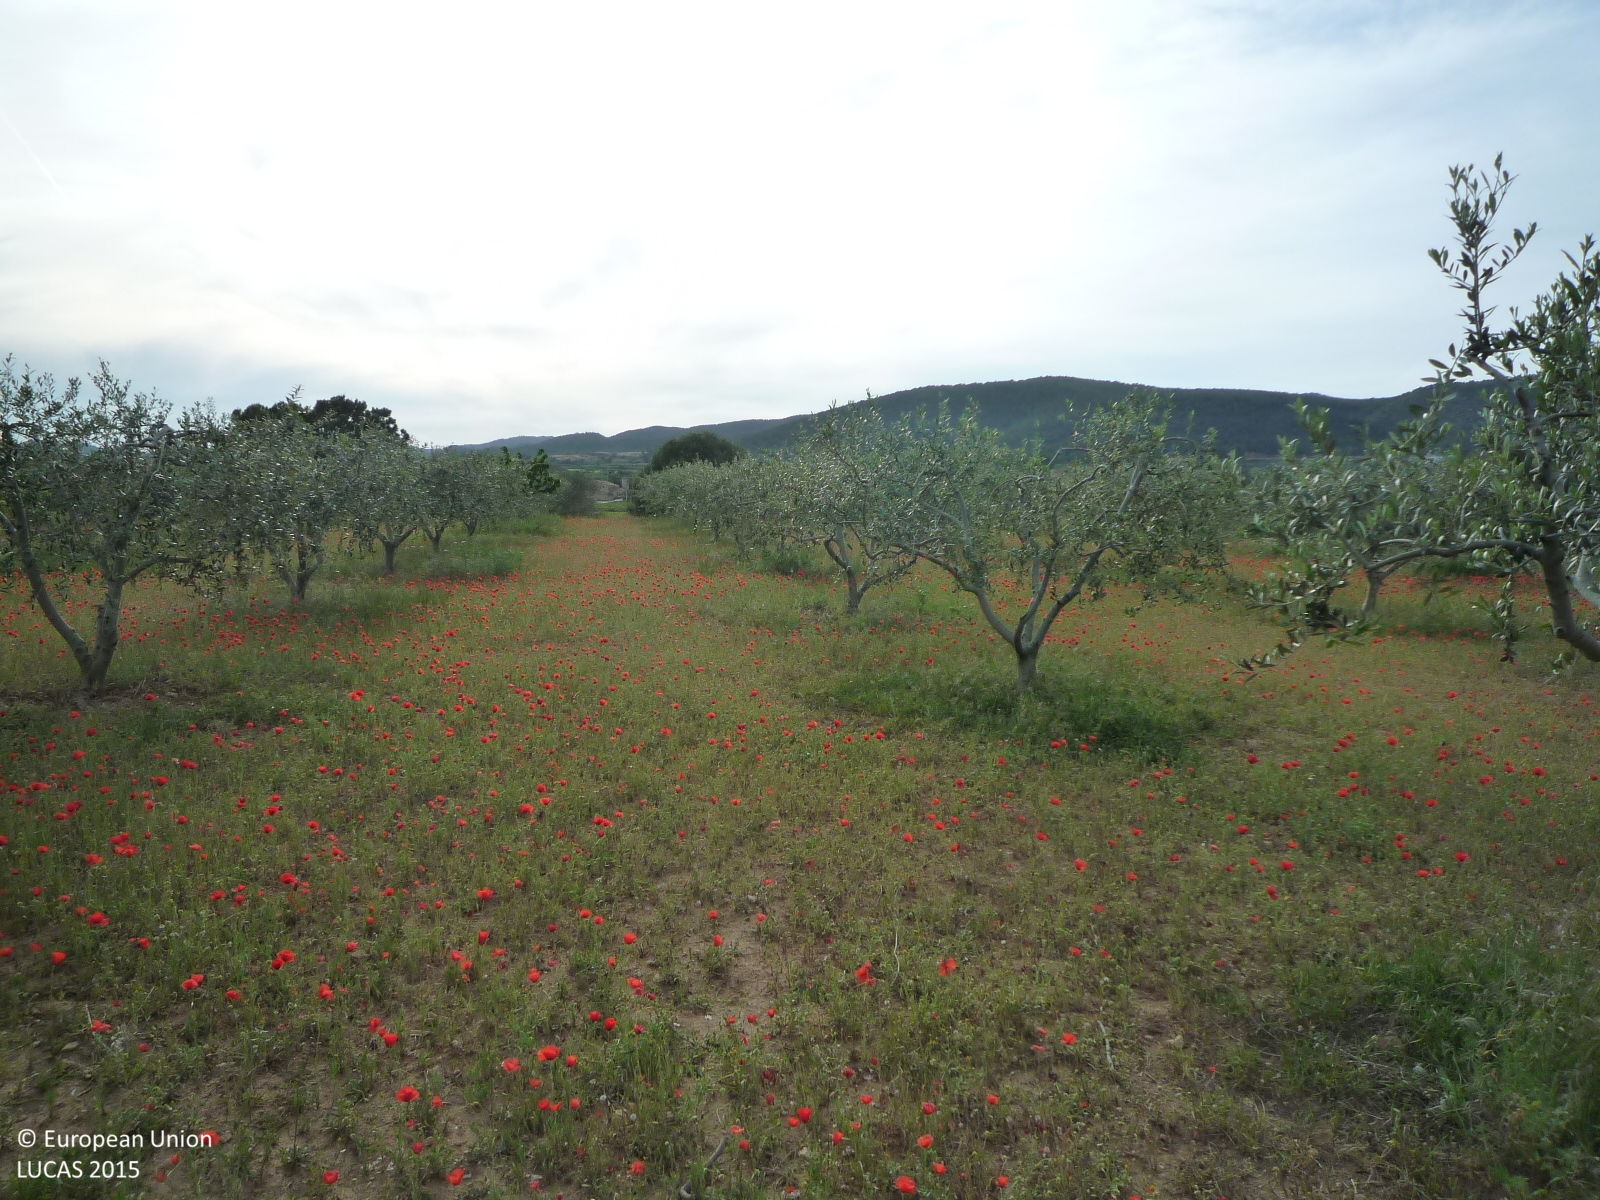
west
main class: Cropland
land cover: Olive groves
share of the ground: 25 - 50 %
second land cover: Spontaneously vegetated surfaces
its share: > 75 %
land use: Agriculture (excluding fallow land and kitchen gardens)
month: April
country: ES
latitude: 41.3237
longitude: 1.5945
